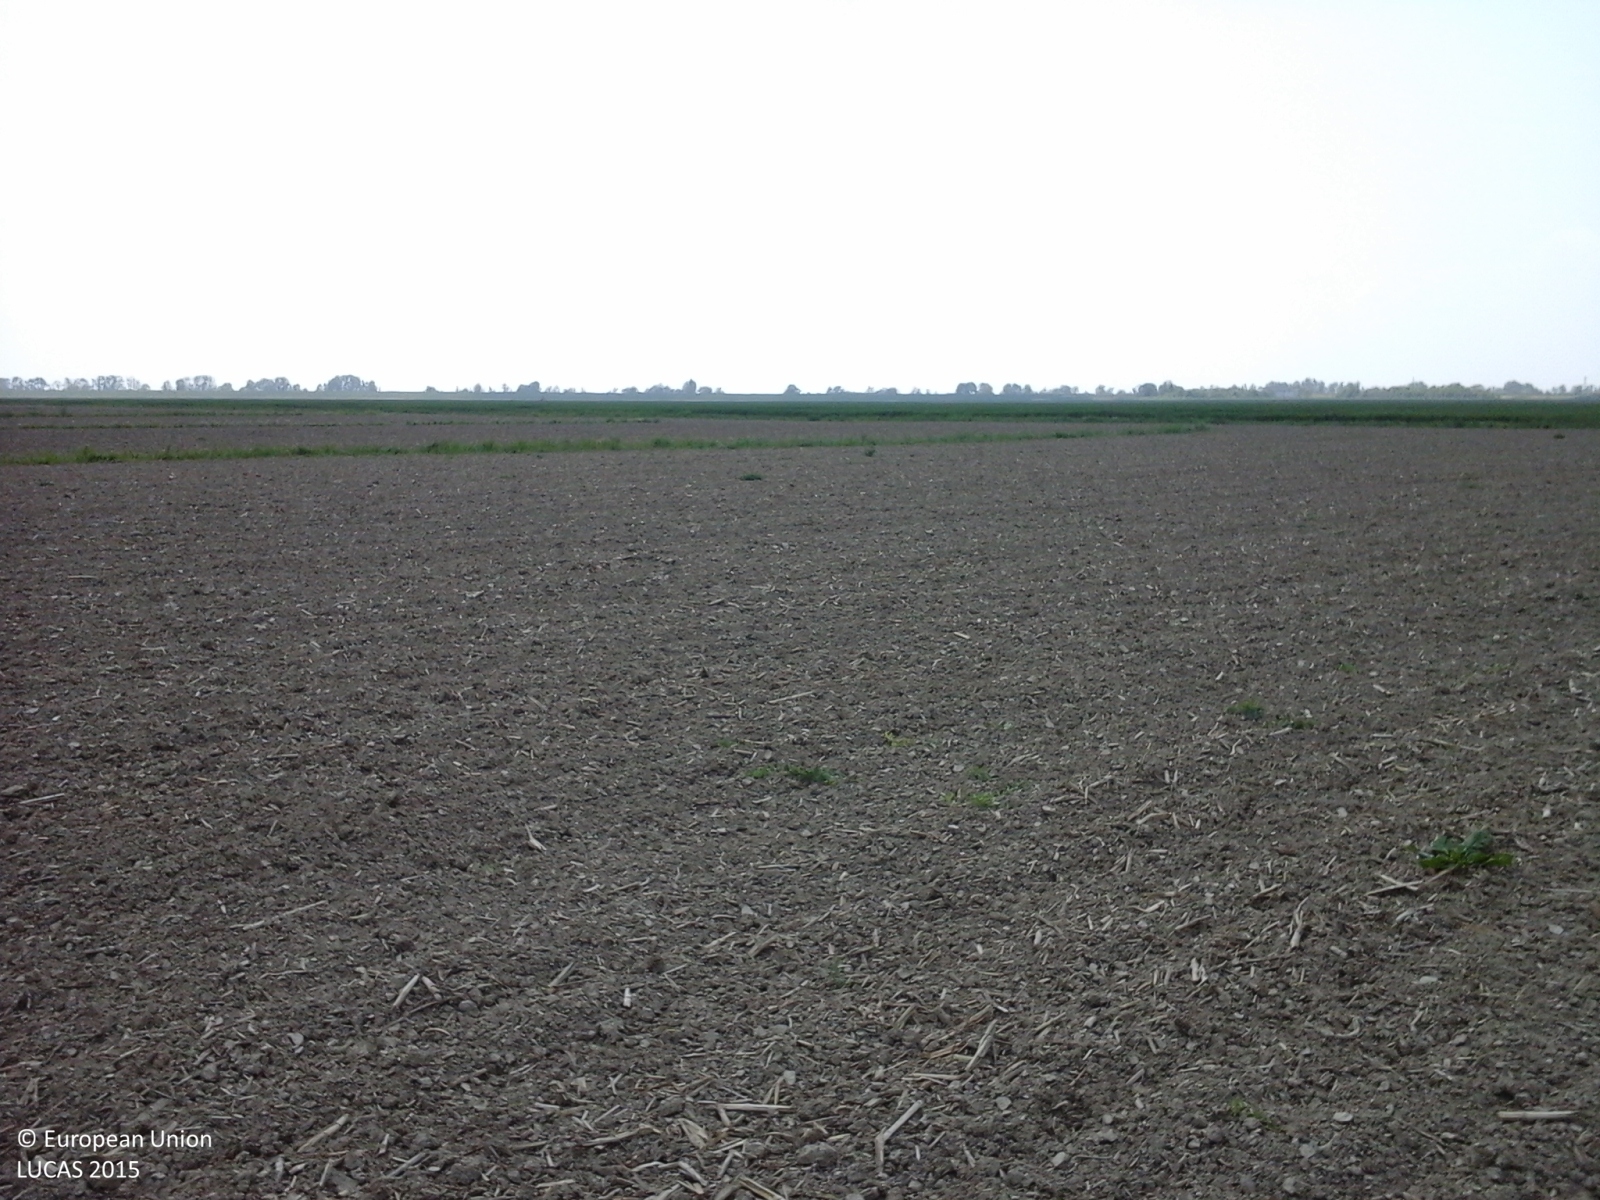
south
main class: Cropland
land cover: Maize
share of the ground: < 10 %
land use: Agriculture (excluding fallow land and kitchen gardens)
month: April
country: IT
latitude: 44.8655
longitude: 12.3371
